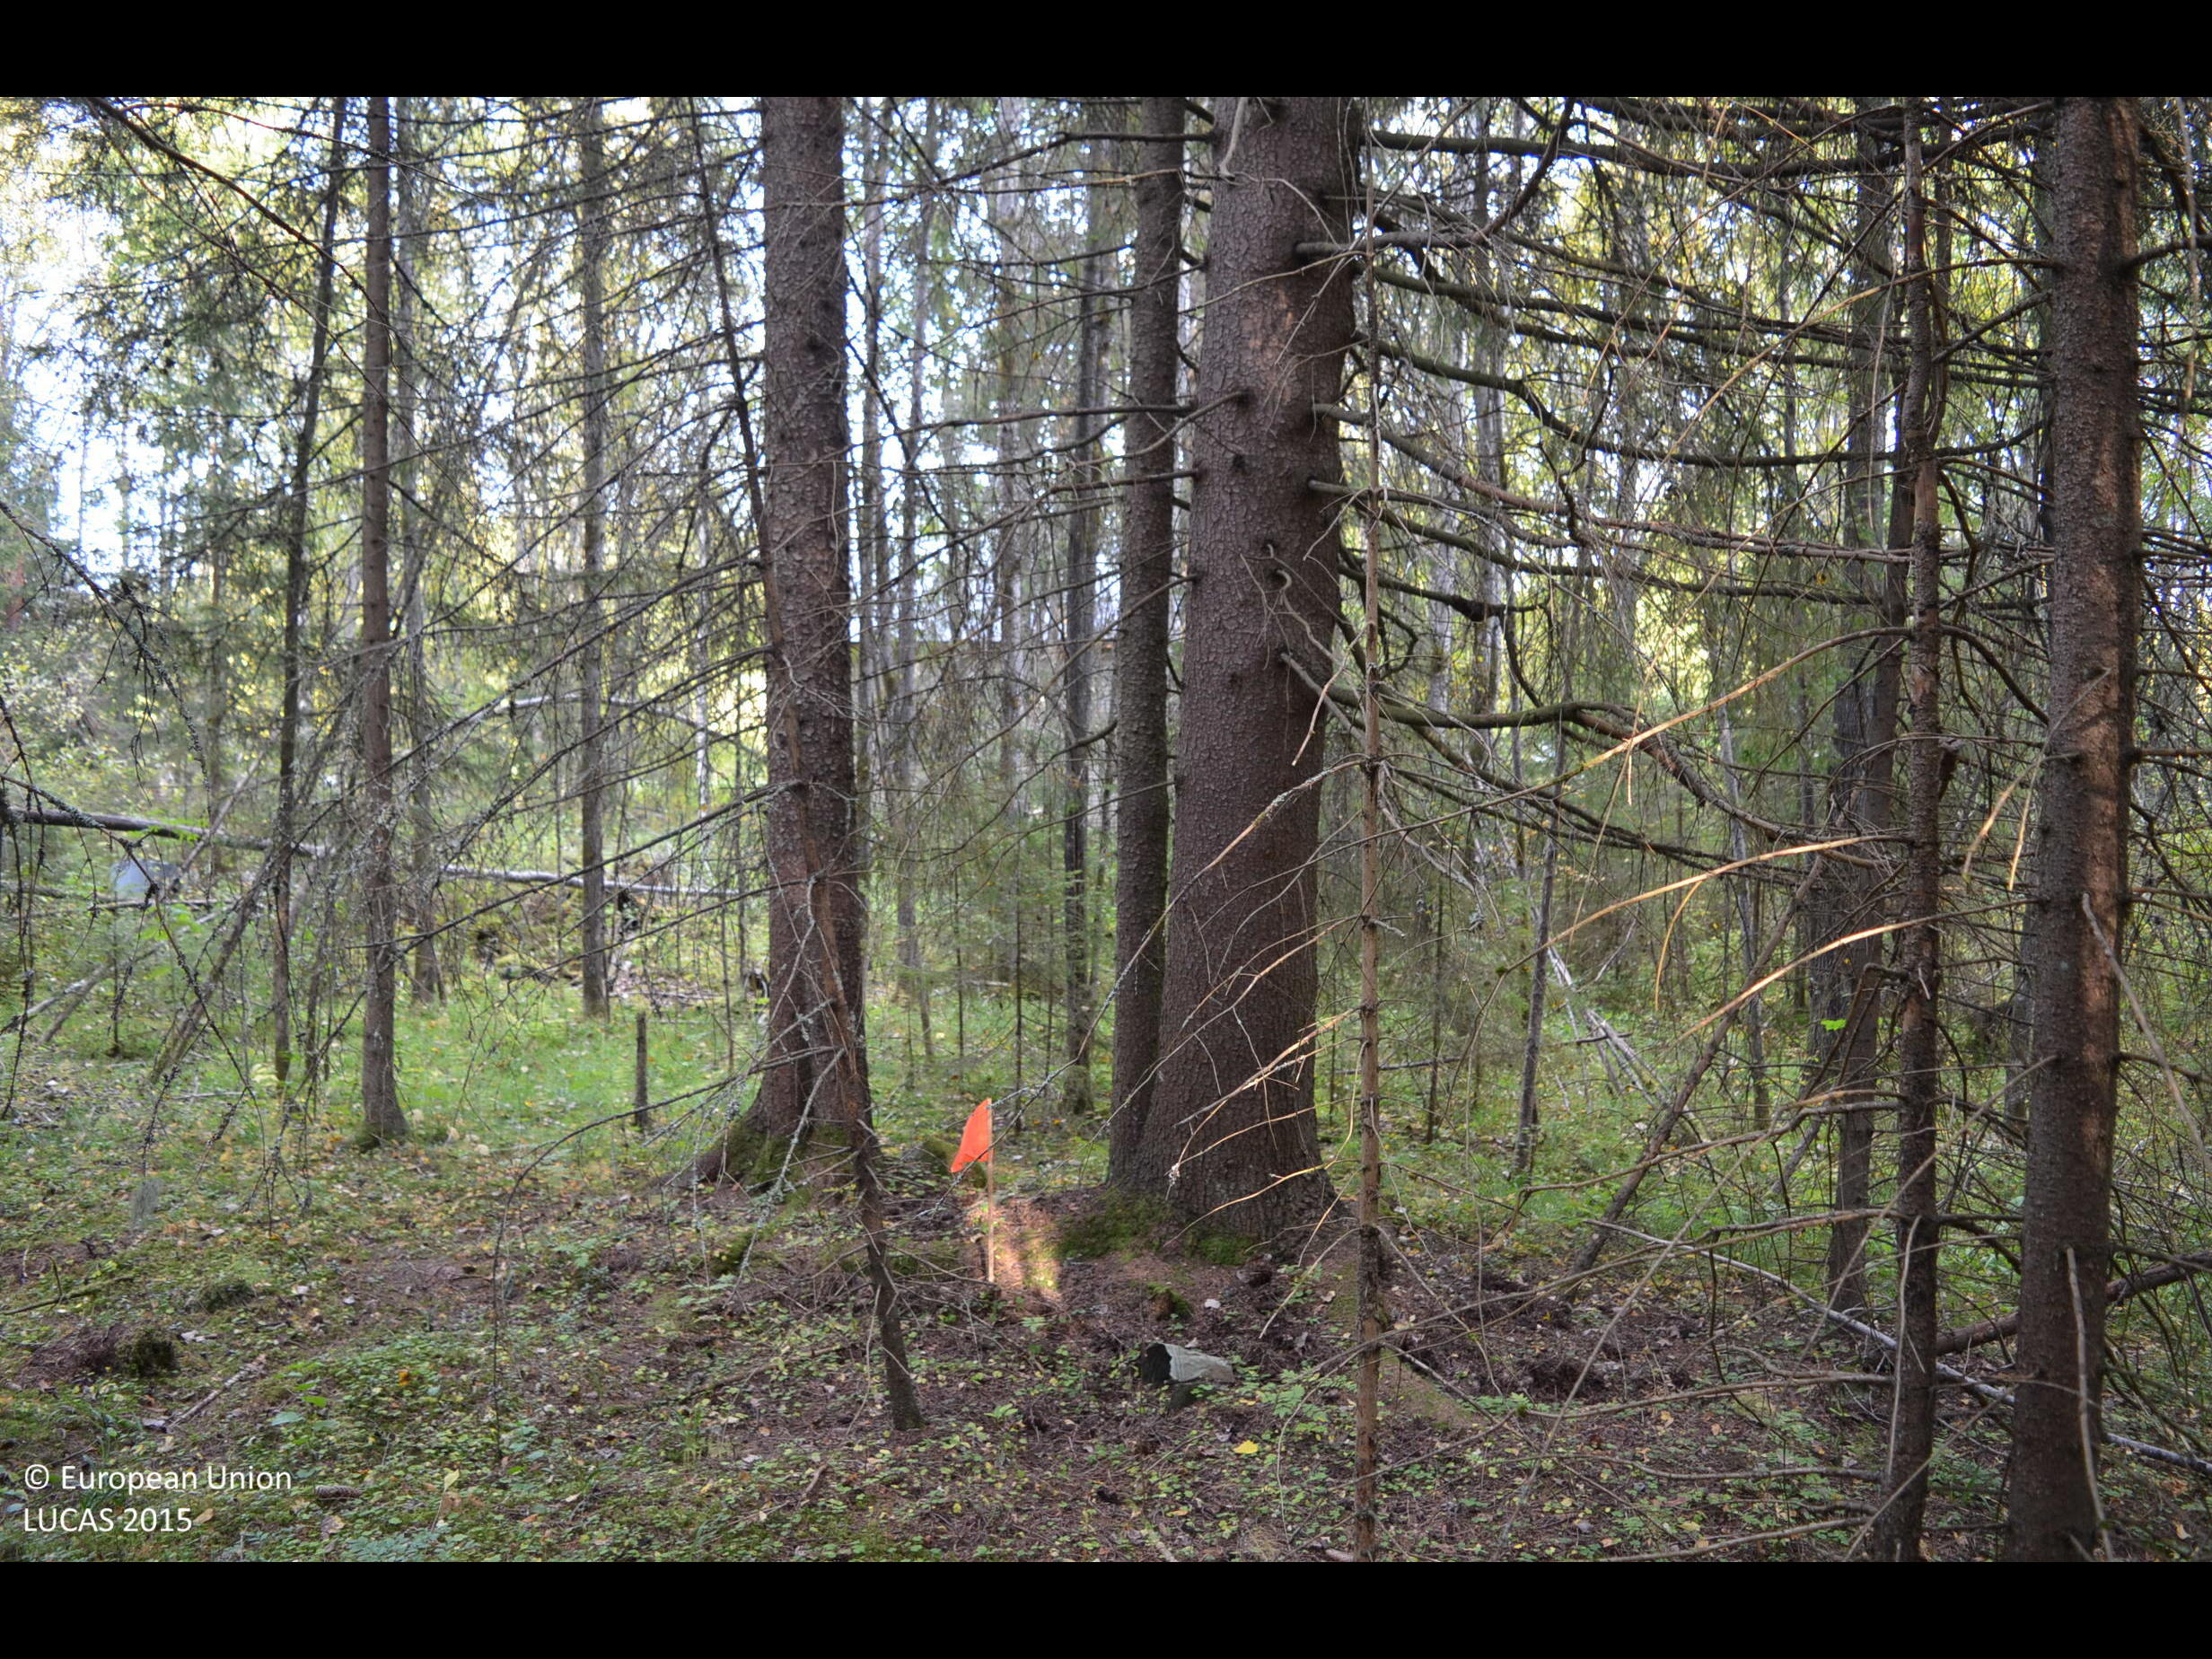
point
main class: Woodland
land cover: Other mixed woodland
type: boreal forest
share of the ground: > 75 %
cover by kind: coniferous forest trees 50 %, broadleaved forest trees 30 %, herbaceous plants 15 %, shrubs 5 %
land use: Forestry
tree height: > 5 m
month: September
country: FI
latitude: 63.0510
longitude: 23.8577
